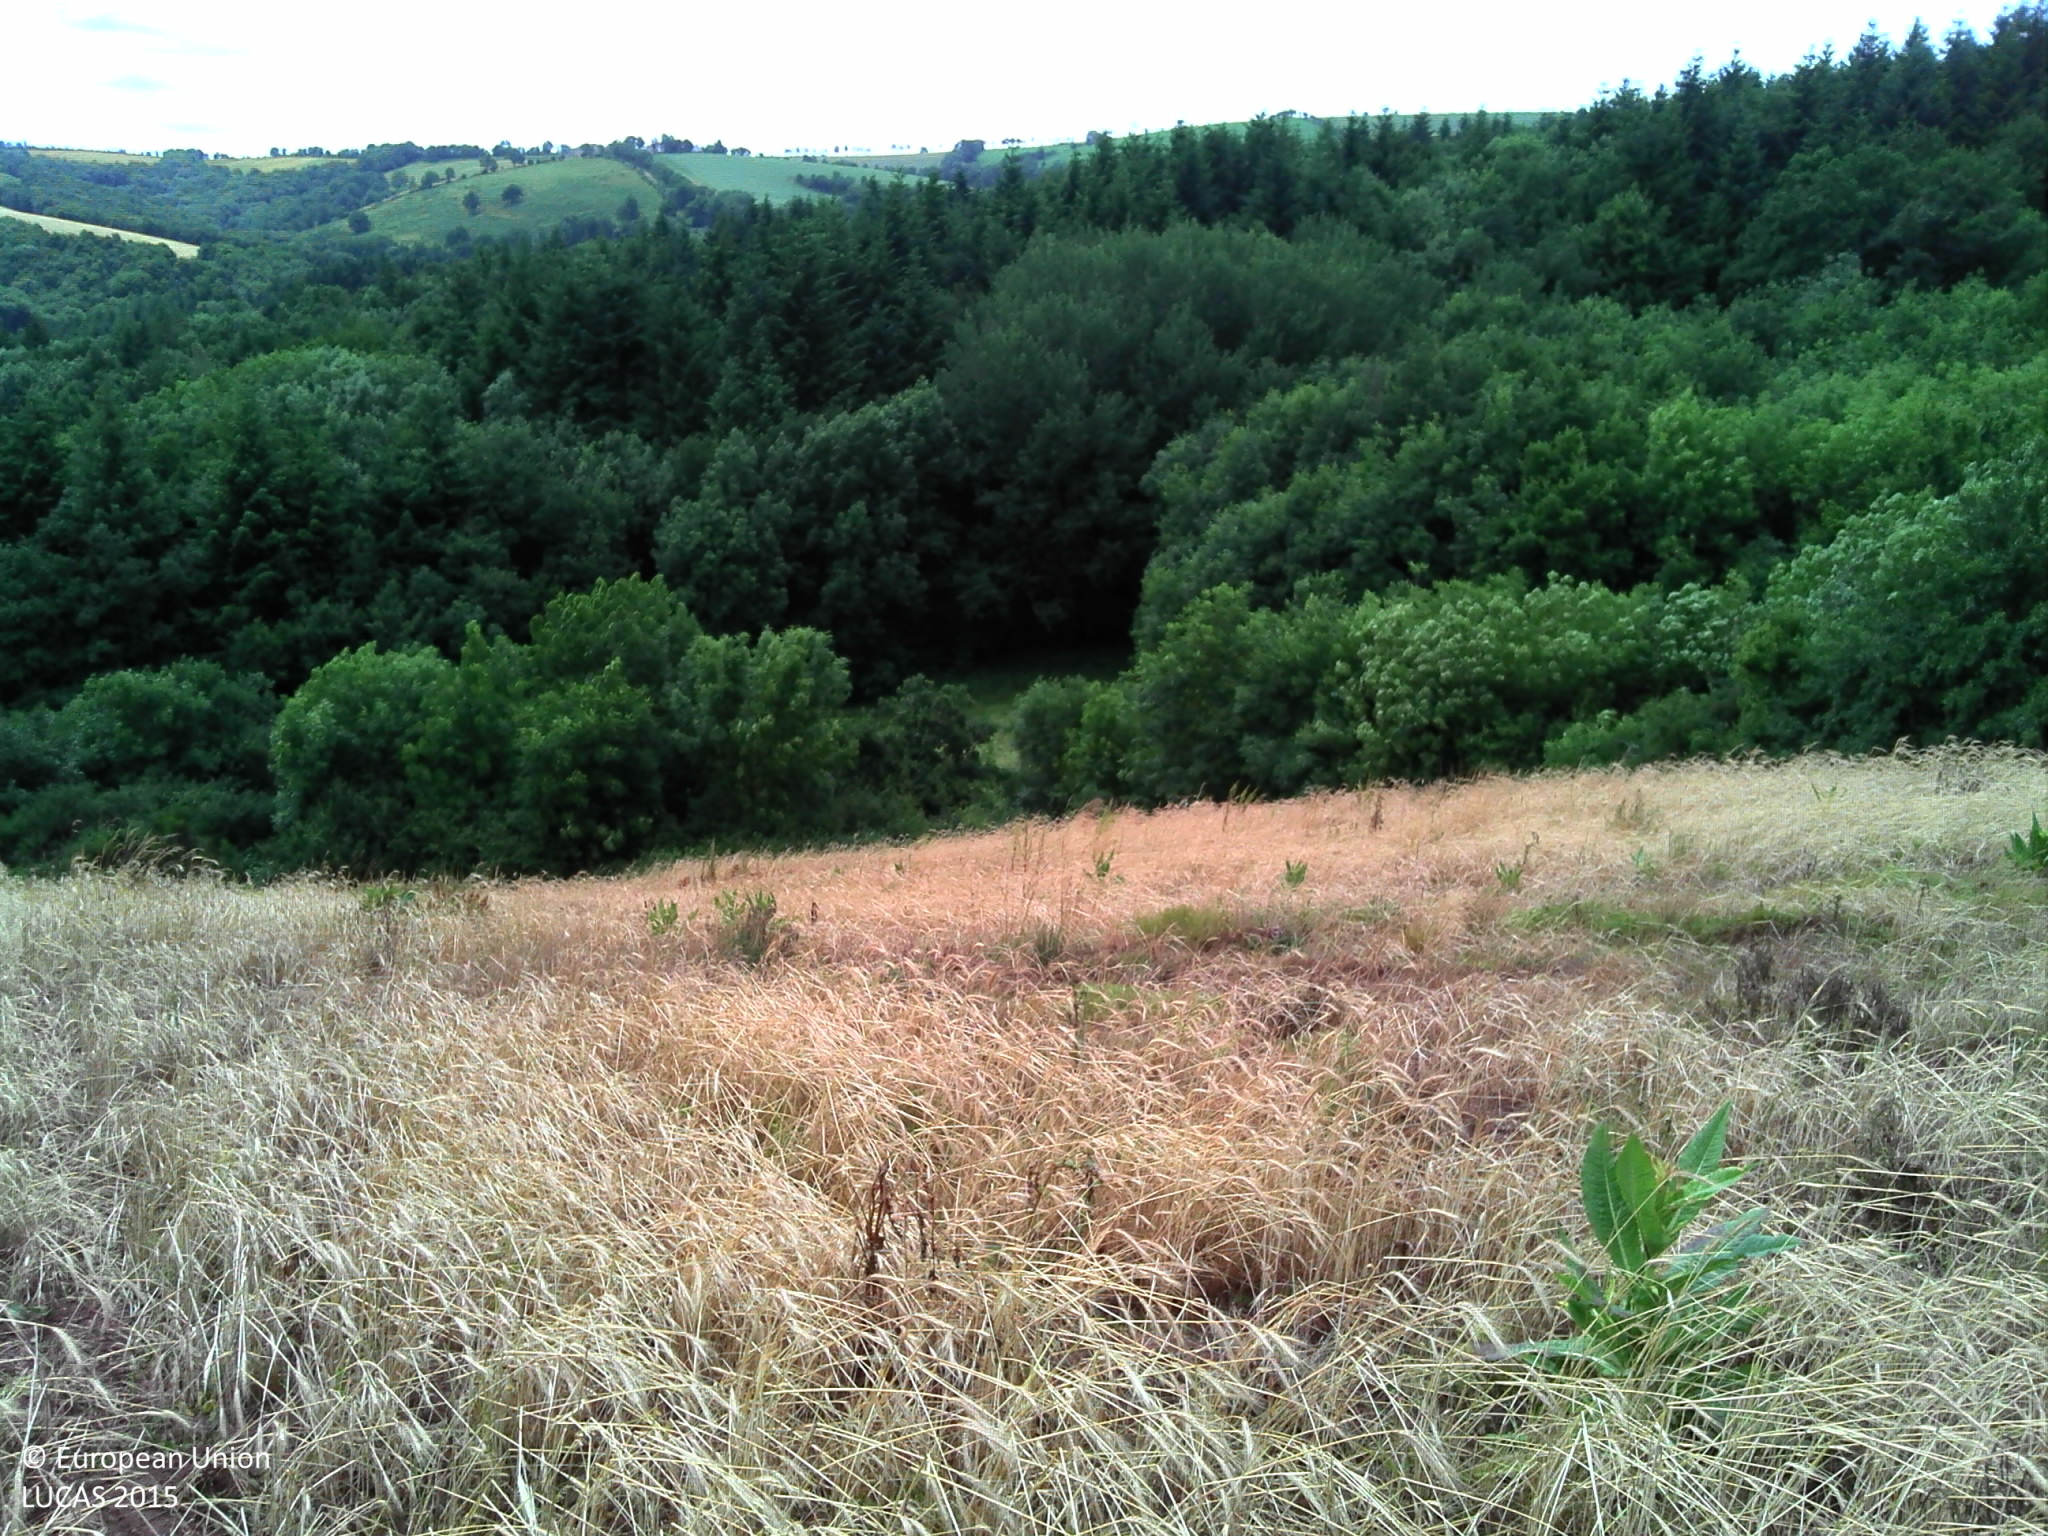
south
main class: Cropland
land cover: Barley
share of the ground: > 75 %
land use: Agriculture (excluding fallow land and kitchen gardens)
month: June
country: FR
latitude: 44.2983
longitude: 3.0487
